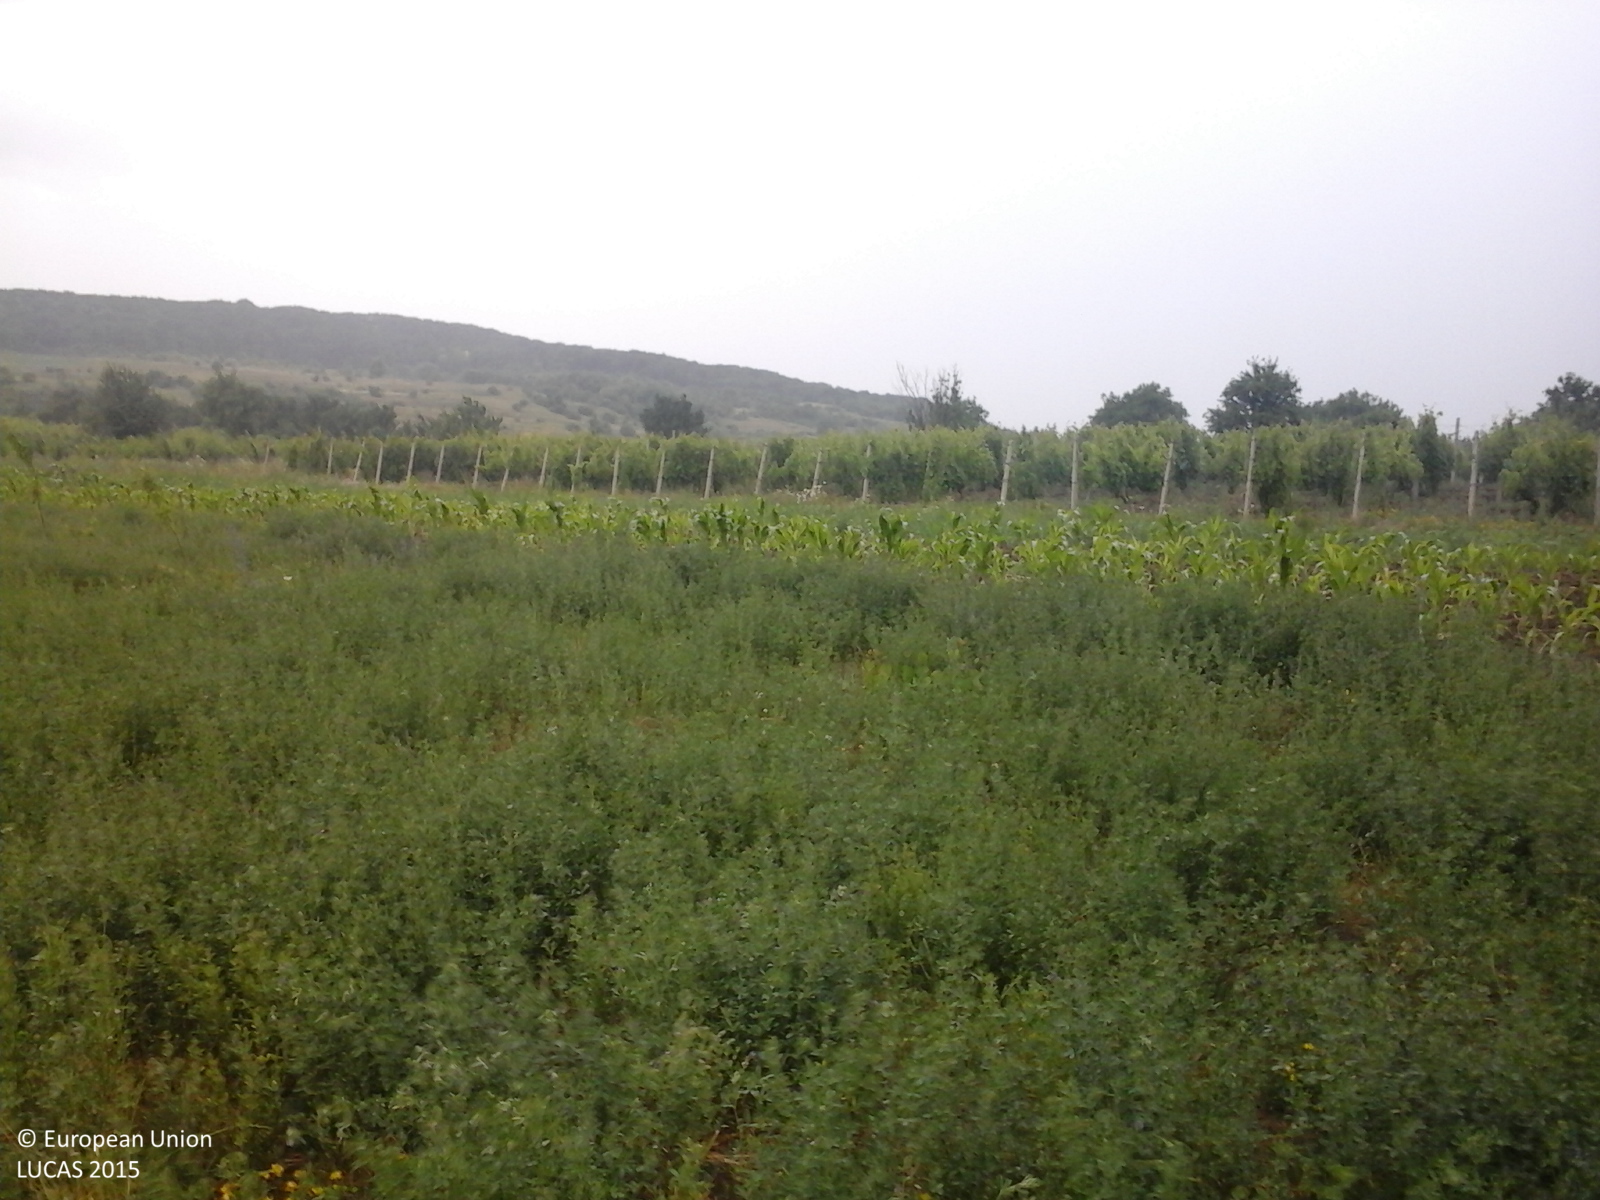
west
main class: Cropland
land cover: Lucerne
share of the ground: > 75 %
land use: Agriculture (excluding fallow land and kitchen gardens)
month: June
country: RO
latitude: 47.3261
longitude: 26.9170
